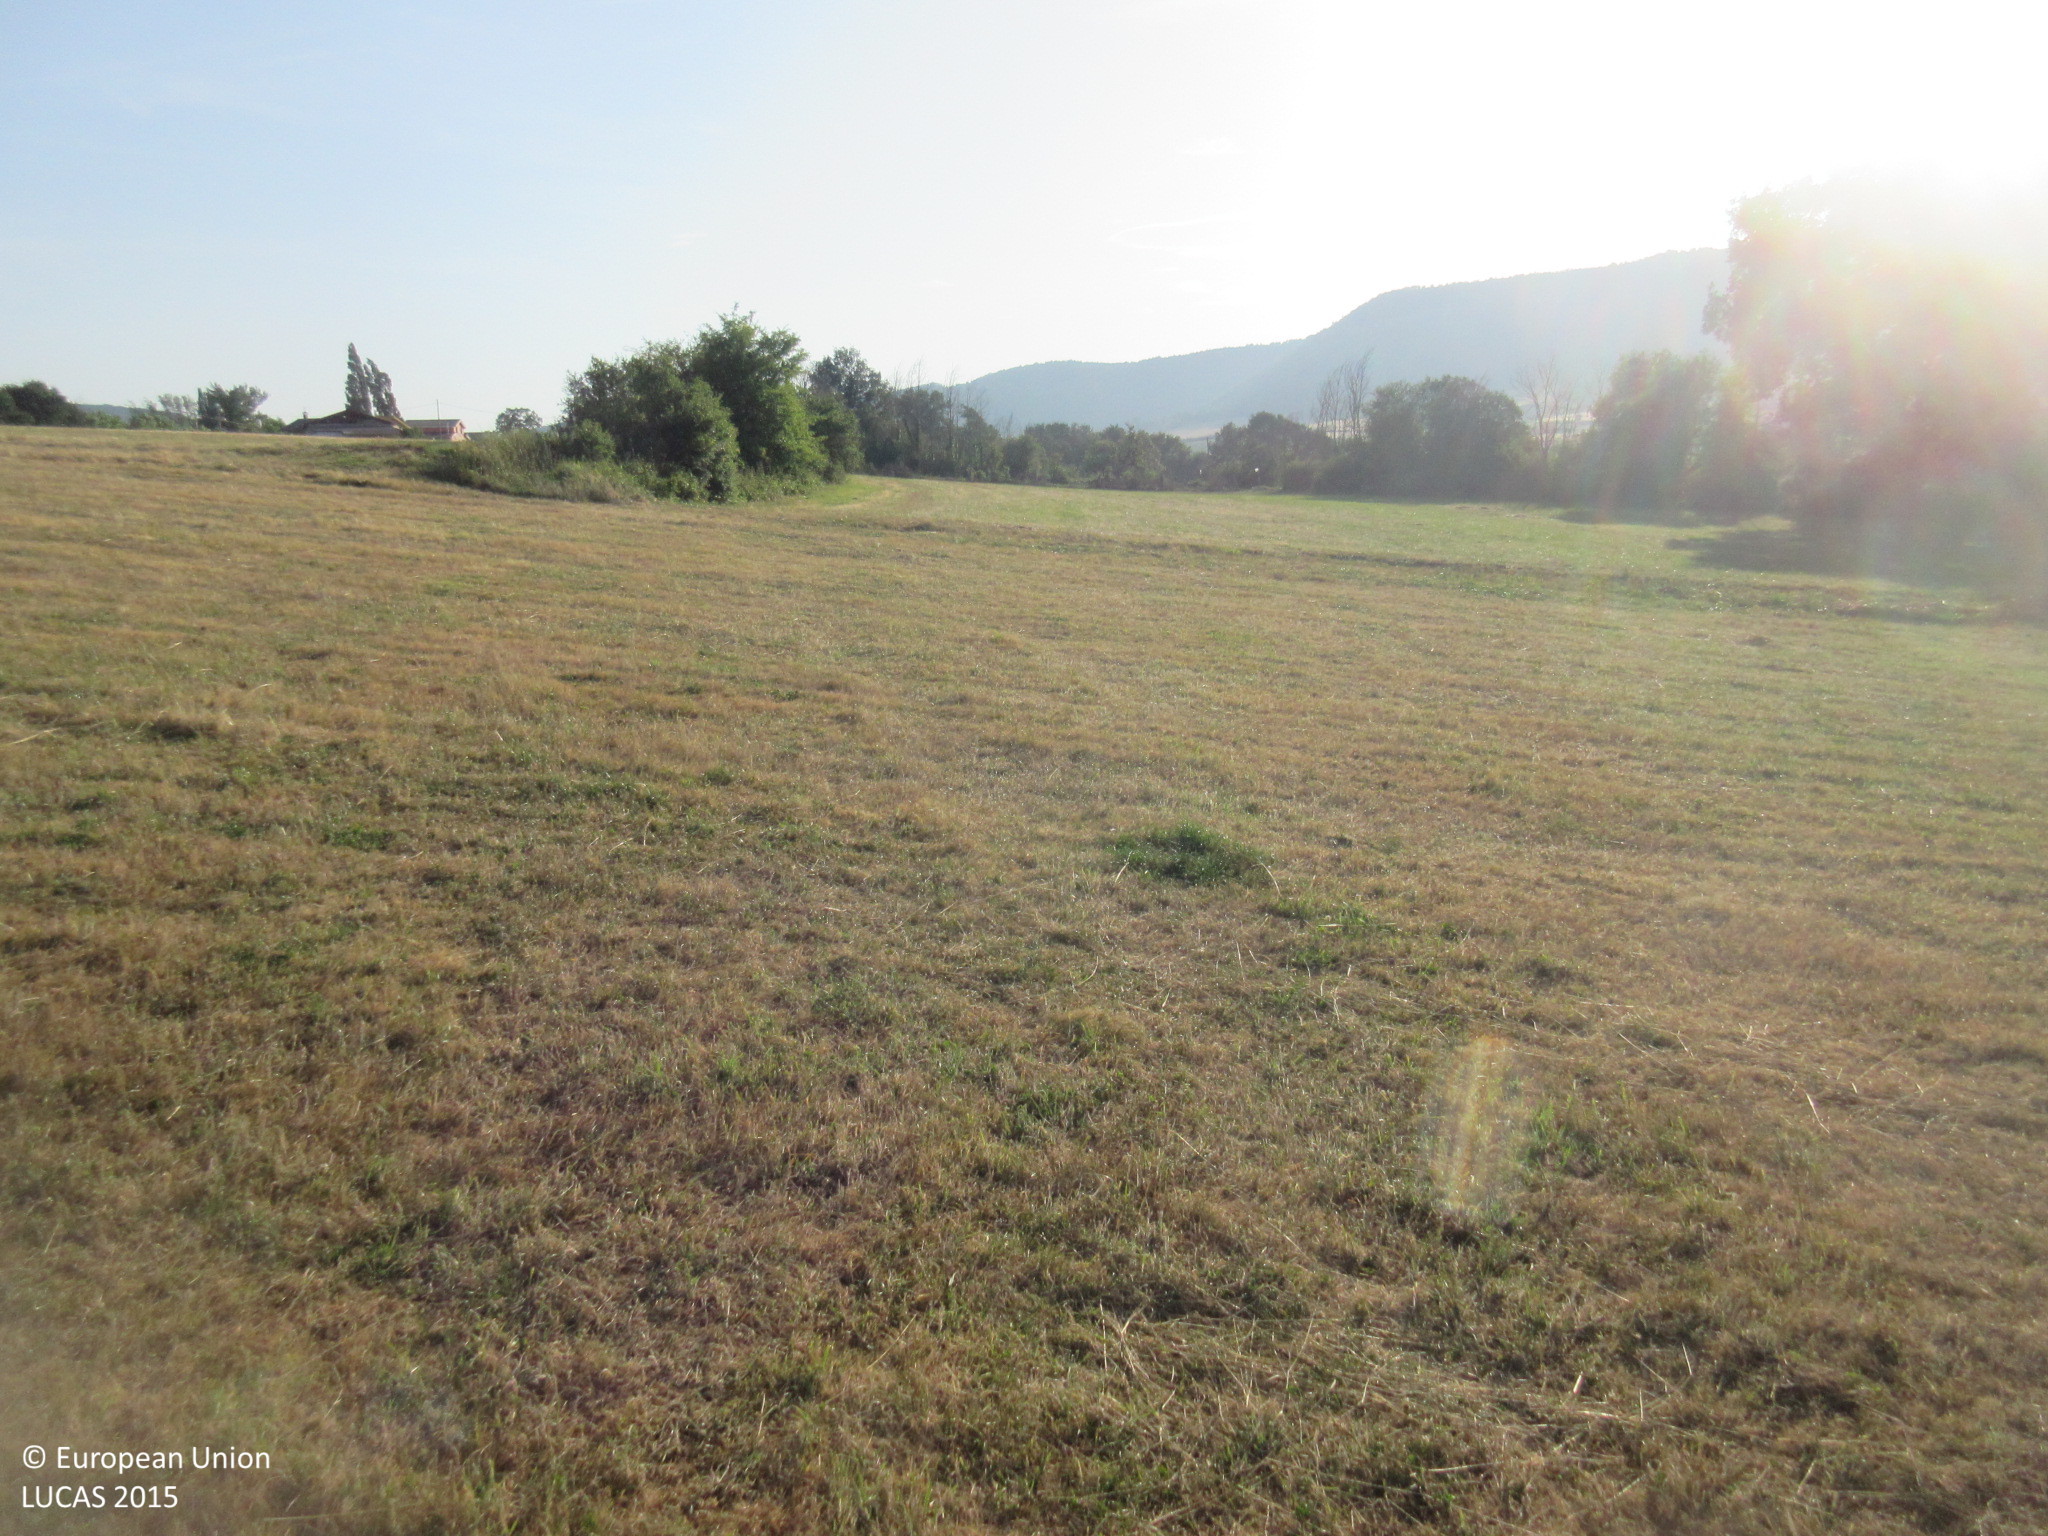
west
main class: Grassland
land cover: Grassland without tree/shrub cover
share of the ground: > 75 %
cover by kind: herbaceous plants 100 %
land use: Agriculture (excluding fallow land and kitchen gardens)
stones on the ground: < 10 %
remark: Harvested field
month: July
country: ES
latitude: 43.0249
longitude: -3.5022
